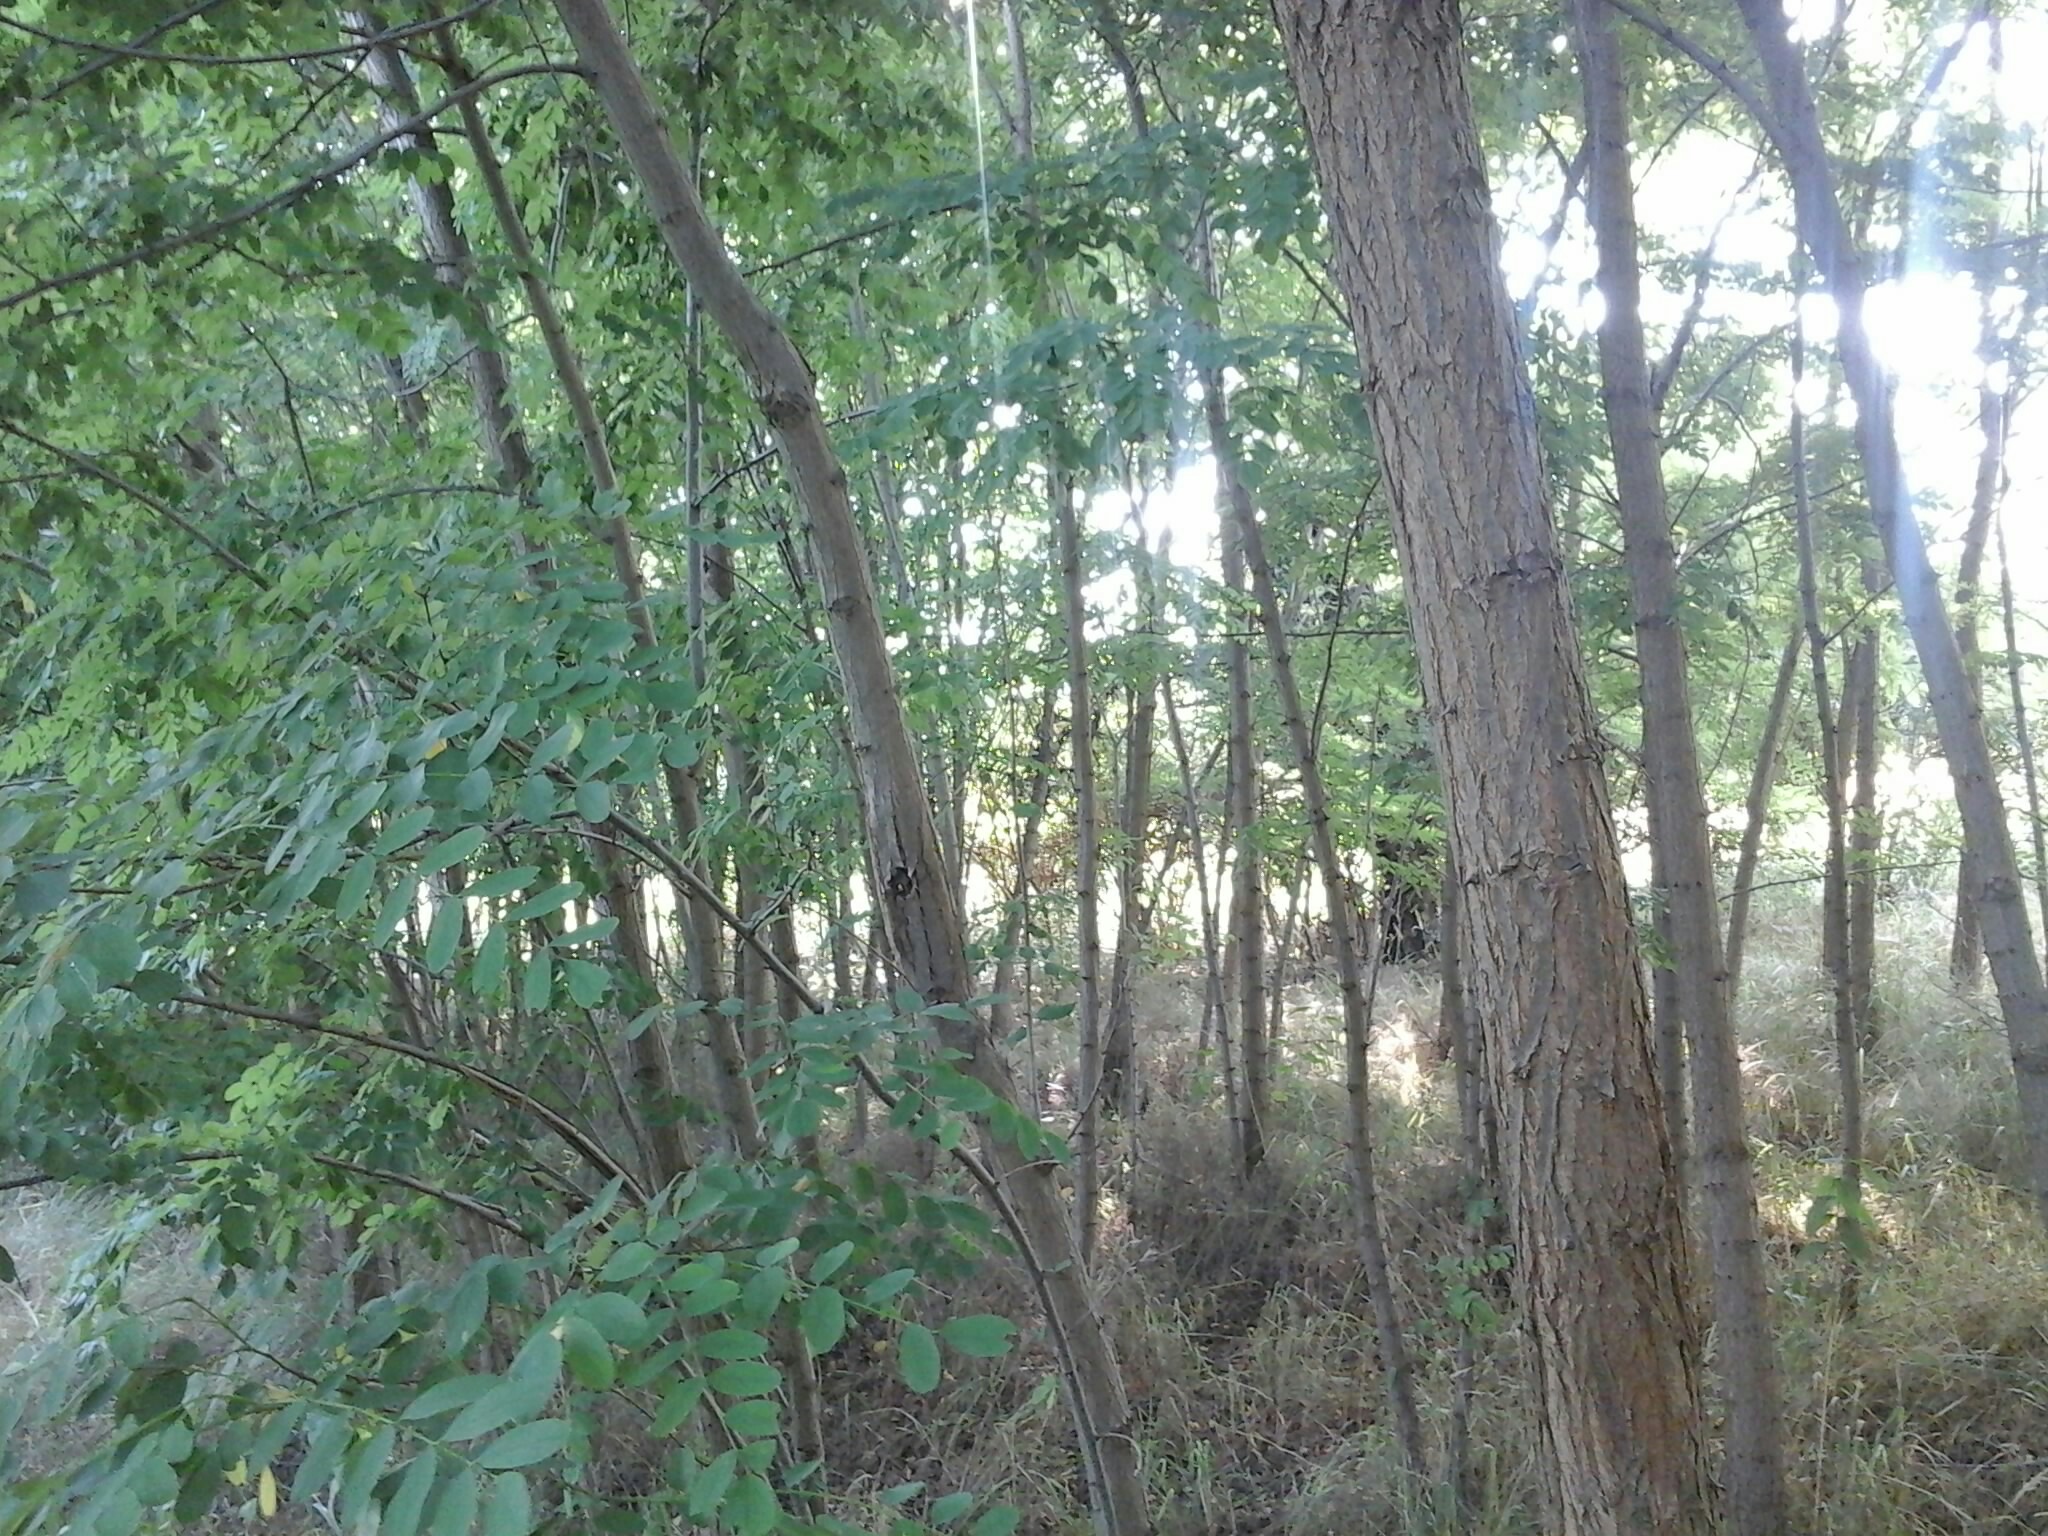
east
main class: Woodland
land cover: Broadleaved woodland
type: exotic forest
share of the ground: > 75 %
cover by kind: broadleaved forest trees 95 %, herbaceous plants 5 %
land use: Forestry
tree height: > 5 m
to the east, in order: Broadleaved woodland; Grassland with sparse tree/shrub cover; Grassland without tree/shrub cover; Vineyards; Grass margins; Maize; Broadleaved woodland; Shrubland with sparse tree cover
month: August
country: HU
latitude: 47.5230
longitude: 17.9125
